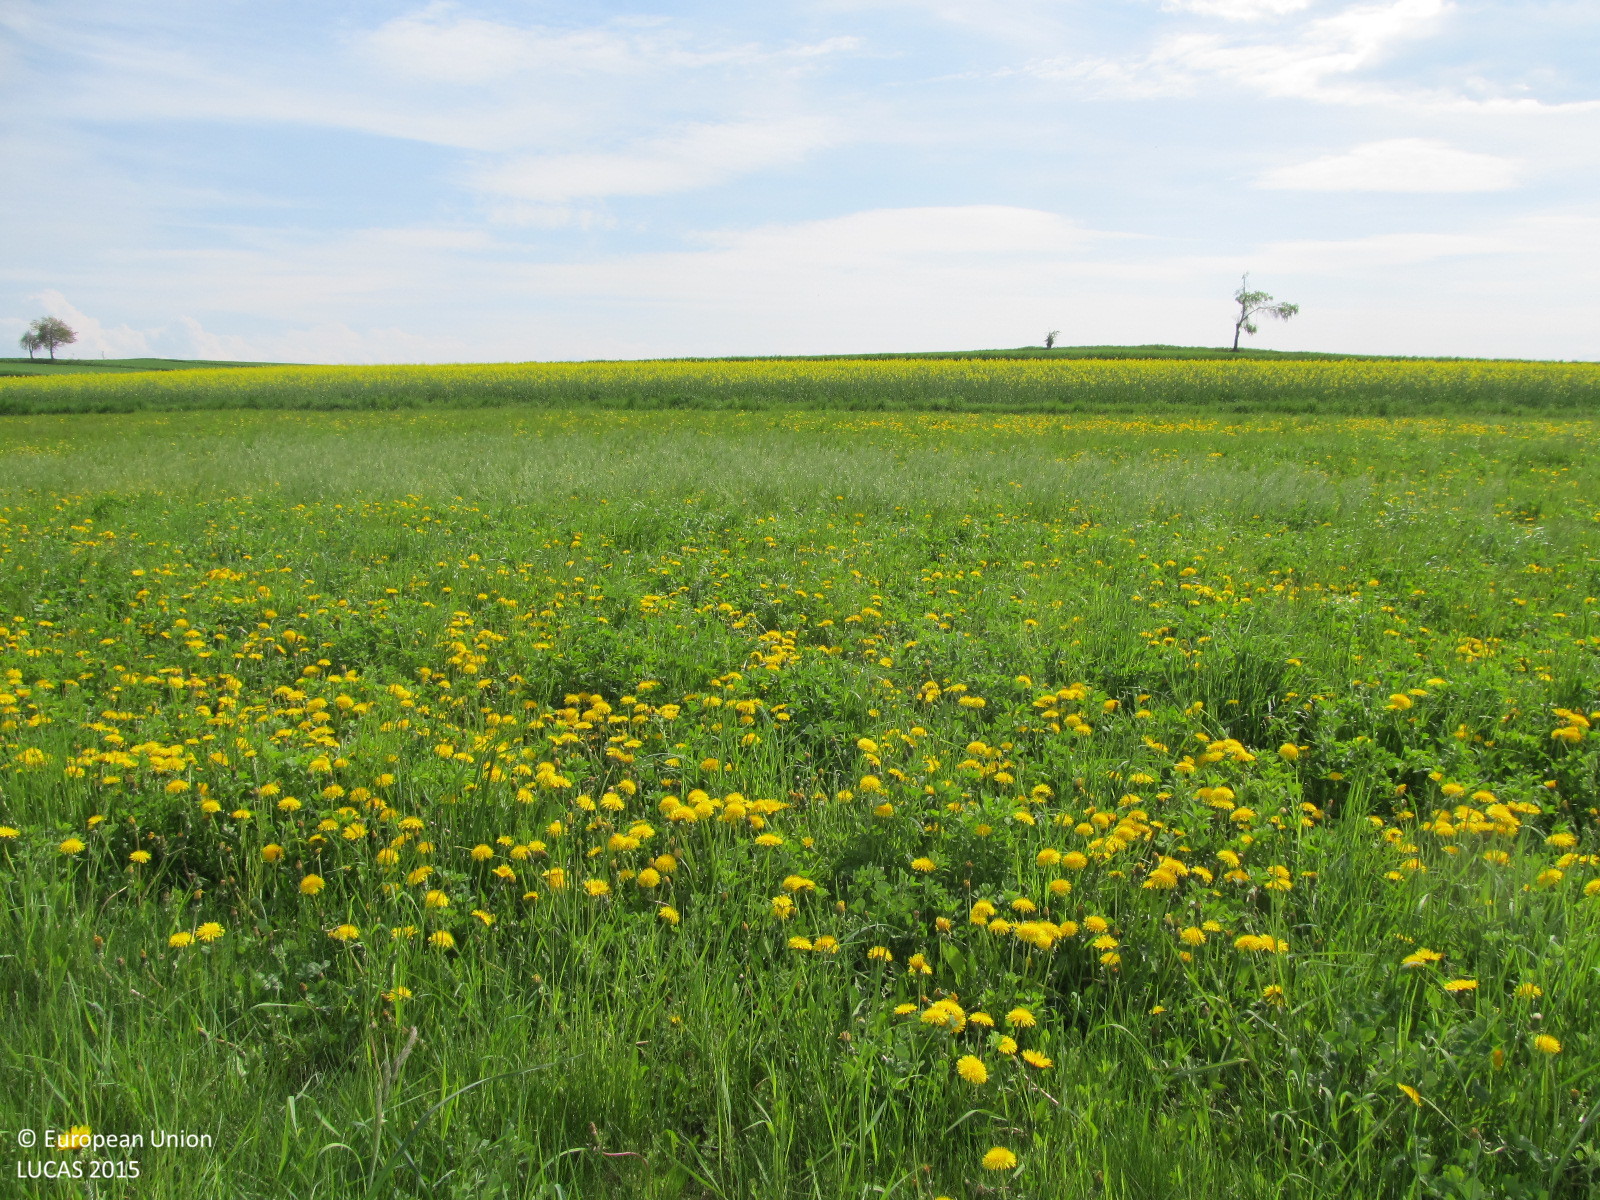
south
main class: Cropland
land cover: Common wheat
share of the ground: 50 - 75 %
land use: Agriculture (excluding fallow land and kitchen gardens)
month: May
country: AT
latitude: 48.5059
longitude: 15.4031
